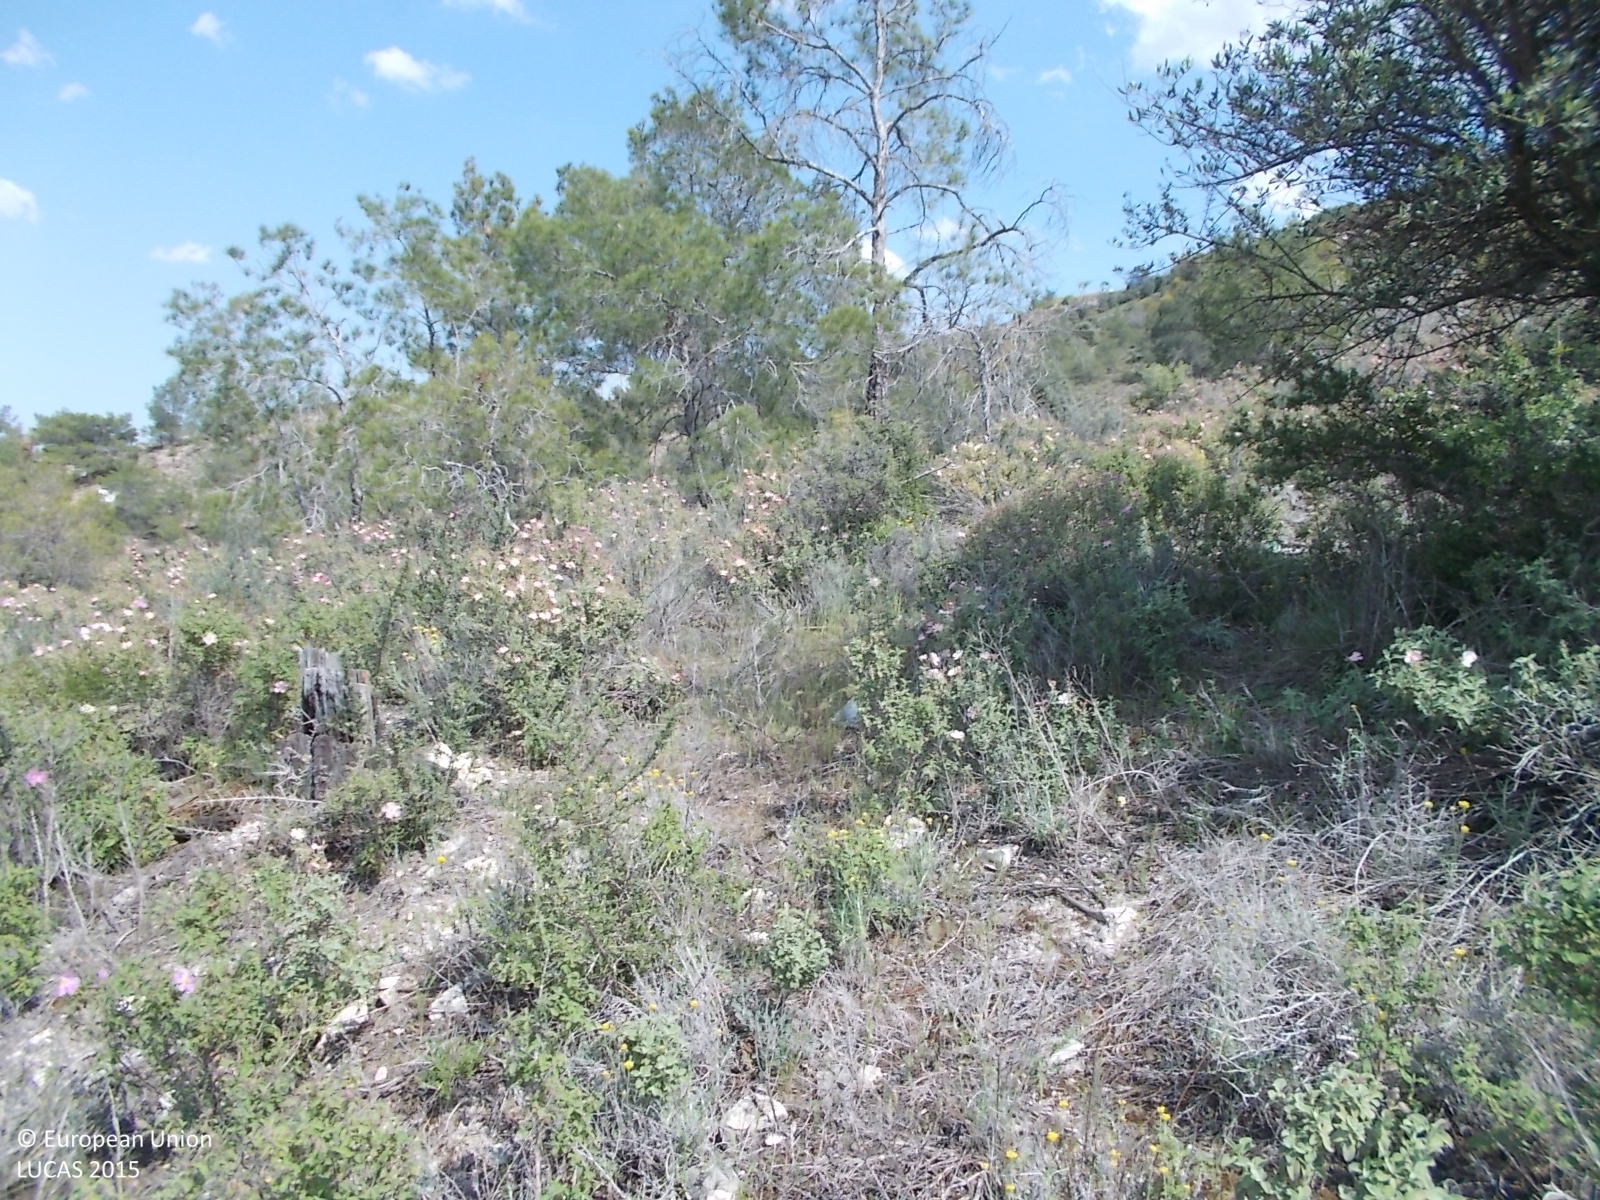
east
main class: Woodland
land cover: Pine dominated coniferous woodland
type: coniferous forest of the mediterranean region
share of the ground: > 75 %
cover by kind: shrubs 70 %, coniferous forest trees 25 %, broadleaved forest trees 5 %
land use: Forestry
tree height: < 5 m
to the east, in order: Pine dominated coniferous woodland; Shrubland with sparse tree cover; Pine dominated coniferous woodland; Rivers and streams; Pine dominated coniferous woodland; Shrubland without tree cover; Pine dominated coniferous woodland; Rivers and streams; Pine dominated coniferous woodland; Paved roads, cycling and walking lanes; Shrubland with sparse tree cover; Other bare soil; Shrubland with sparse tree cover
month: April
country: CY
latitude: 34.9389
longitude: 33.4559
